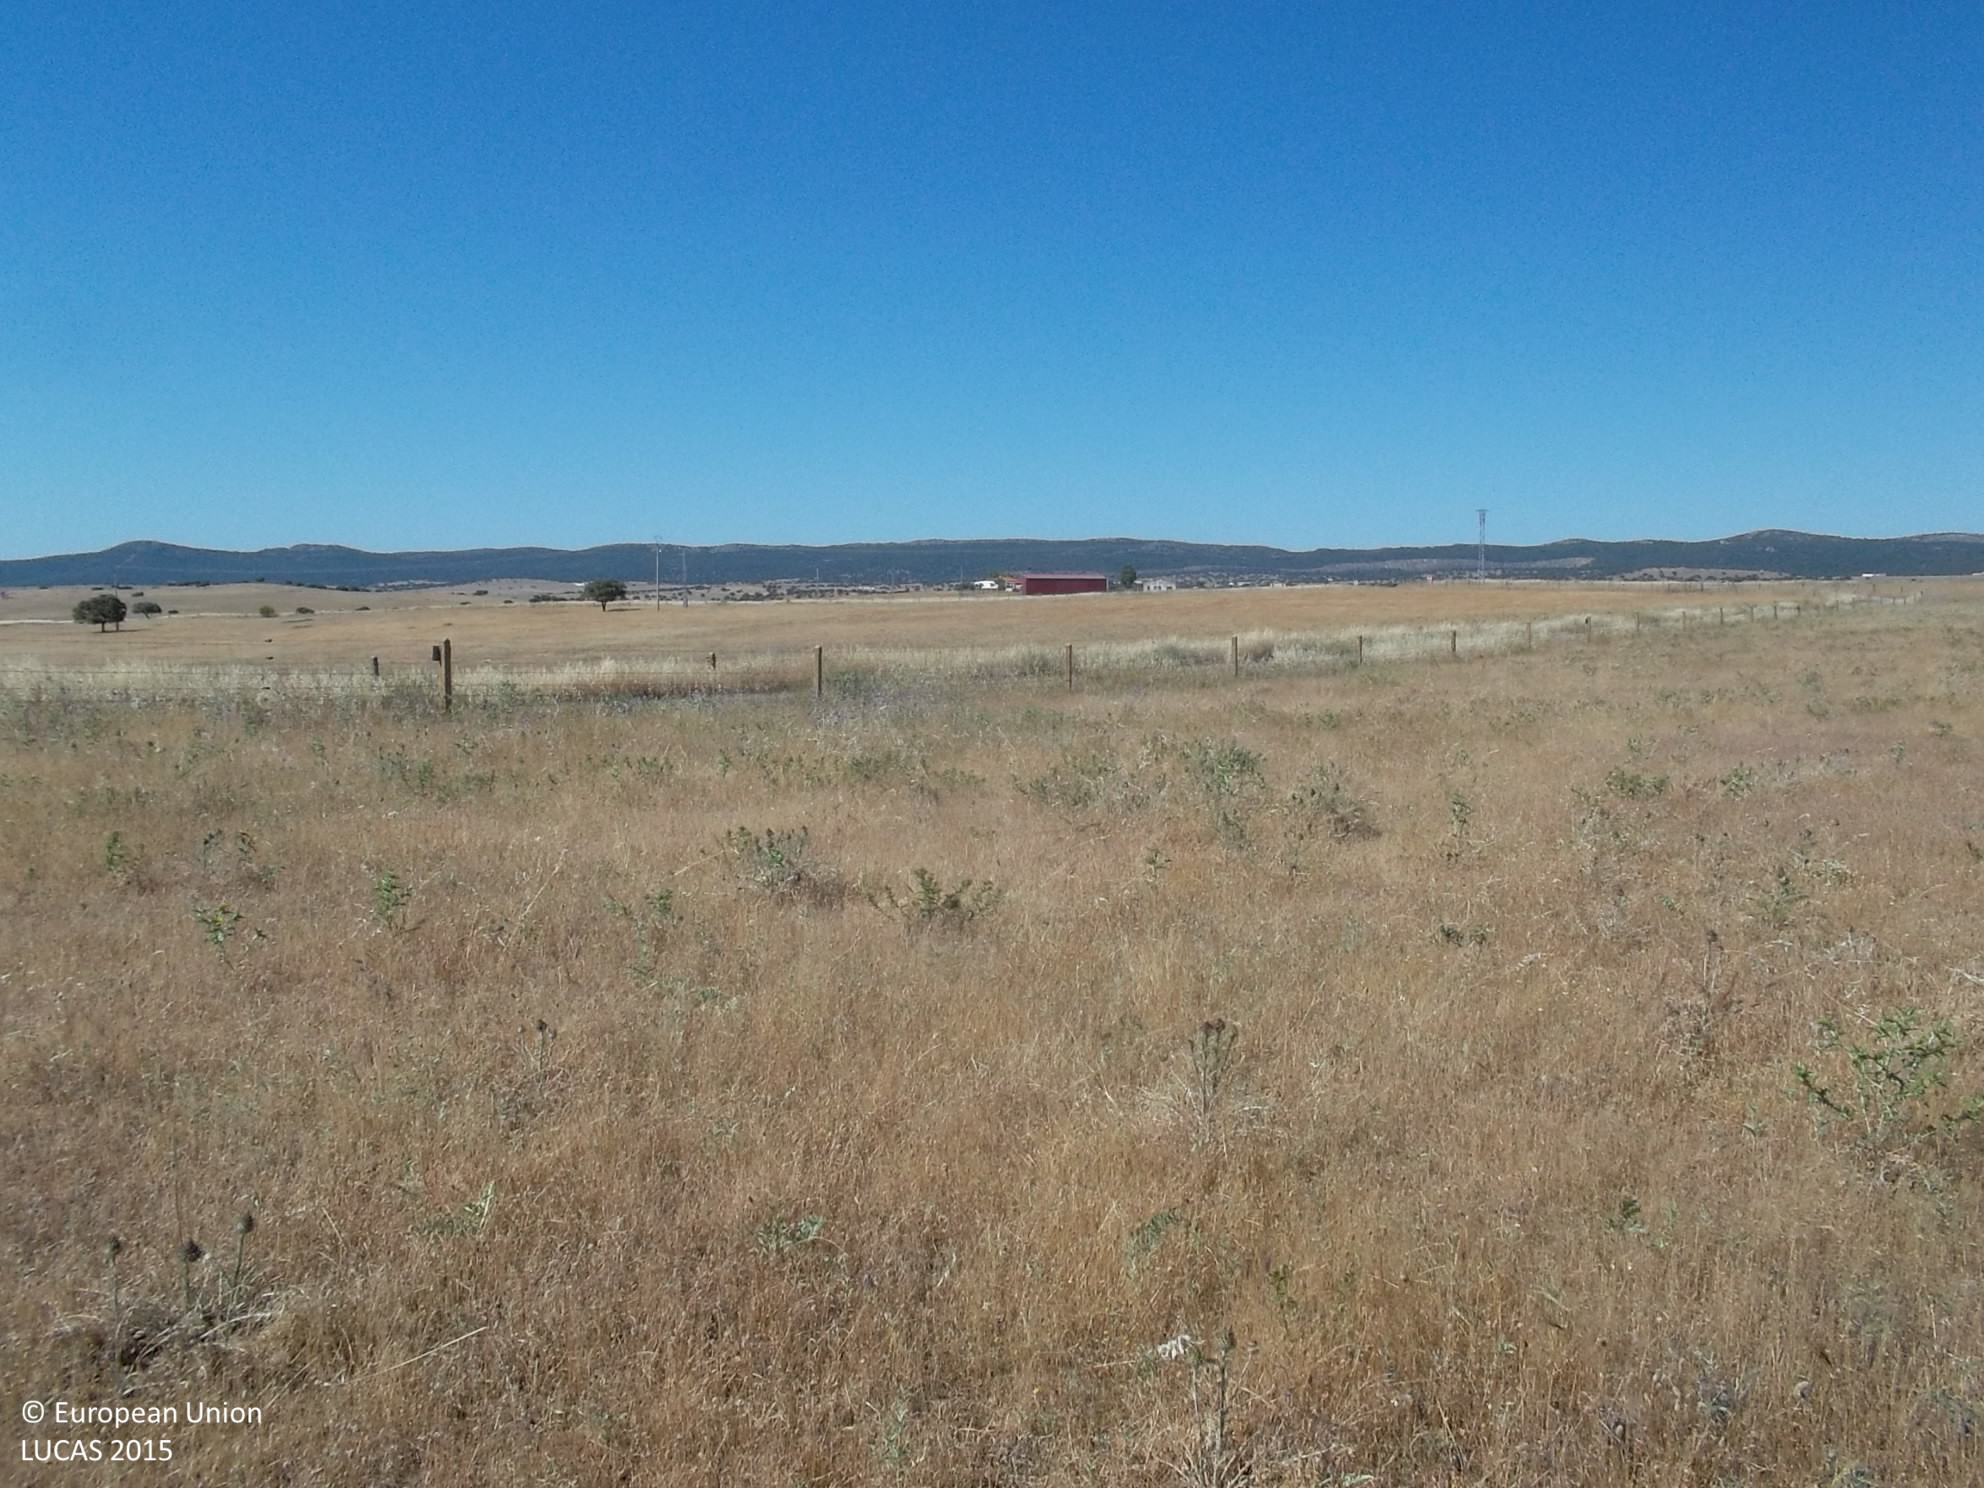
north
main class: Grassland
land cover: Grassland without tree/shrub cover
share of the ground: > 75 %
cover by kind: herbaceous plants 100 %
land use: Agriculture (excluding fallow land and kitchen gardens)
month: May
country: ES
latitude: 38.6243
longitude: -4.4368
